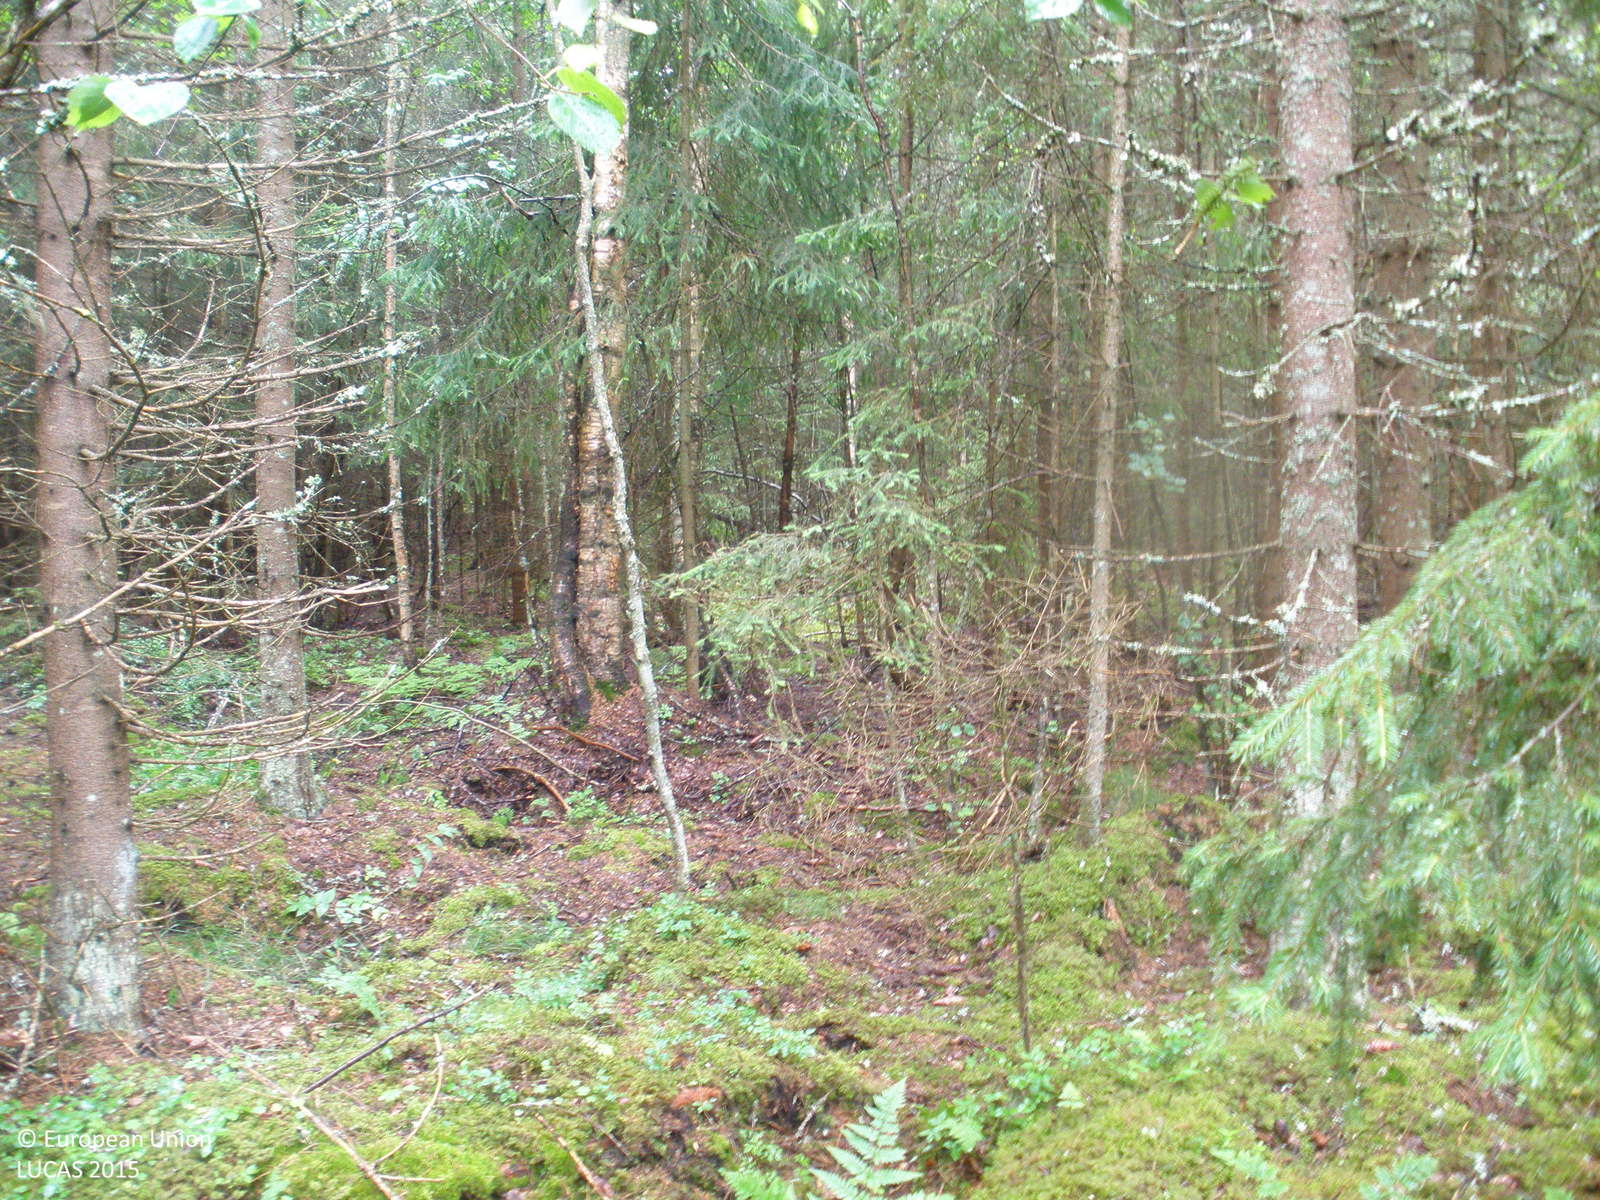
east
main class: Woodland
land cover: Spruce dominated coniferous woodland
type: boreal forest
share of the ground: > 75 %
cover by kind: coniferous forest trees 80 %, lichens and mosses 10 %, broadleaved forest trees 5 %, herbaceous plants 5 %
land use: Forestry
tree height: > 5 m
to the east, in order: Spruce dominated coniferous woodland; Broadleaved woodland; Pine dominated coniferous woodland; Spruce dominated mixed woodland; Ditches and canals; Grass margins; Paved roads, cycling and walking lanes; Grass margins; Ditches and canals; Oats; Grass margins; Ditches and canals; Abandoned hedges; Spontaneously vegetated surfaces
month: July
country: FI
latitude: 61.2794
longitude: 23.7598
